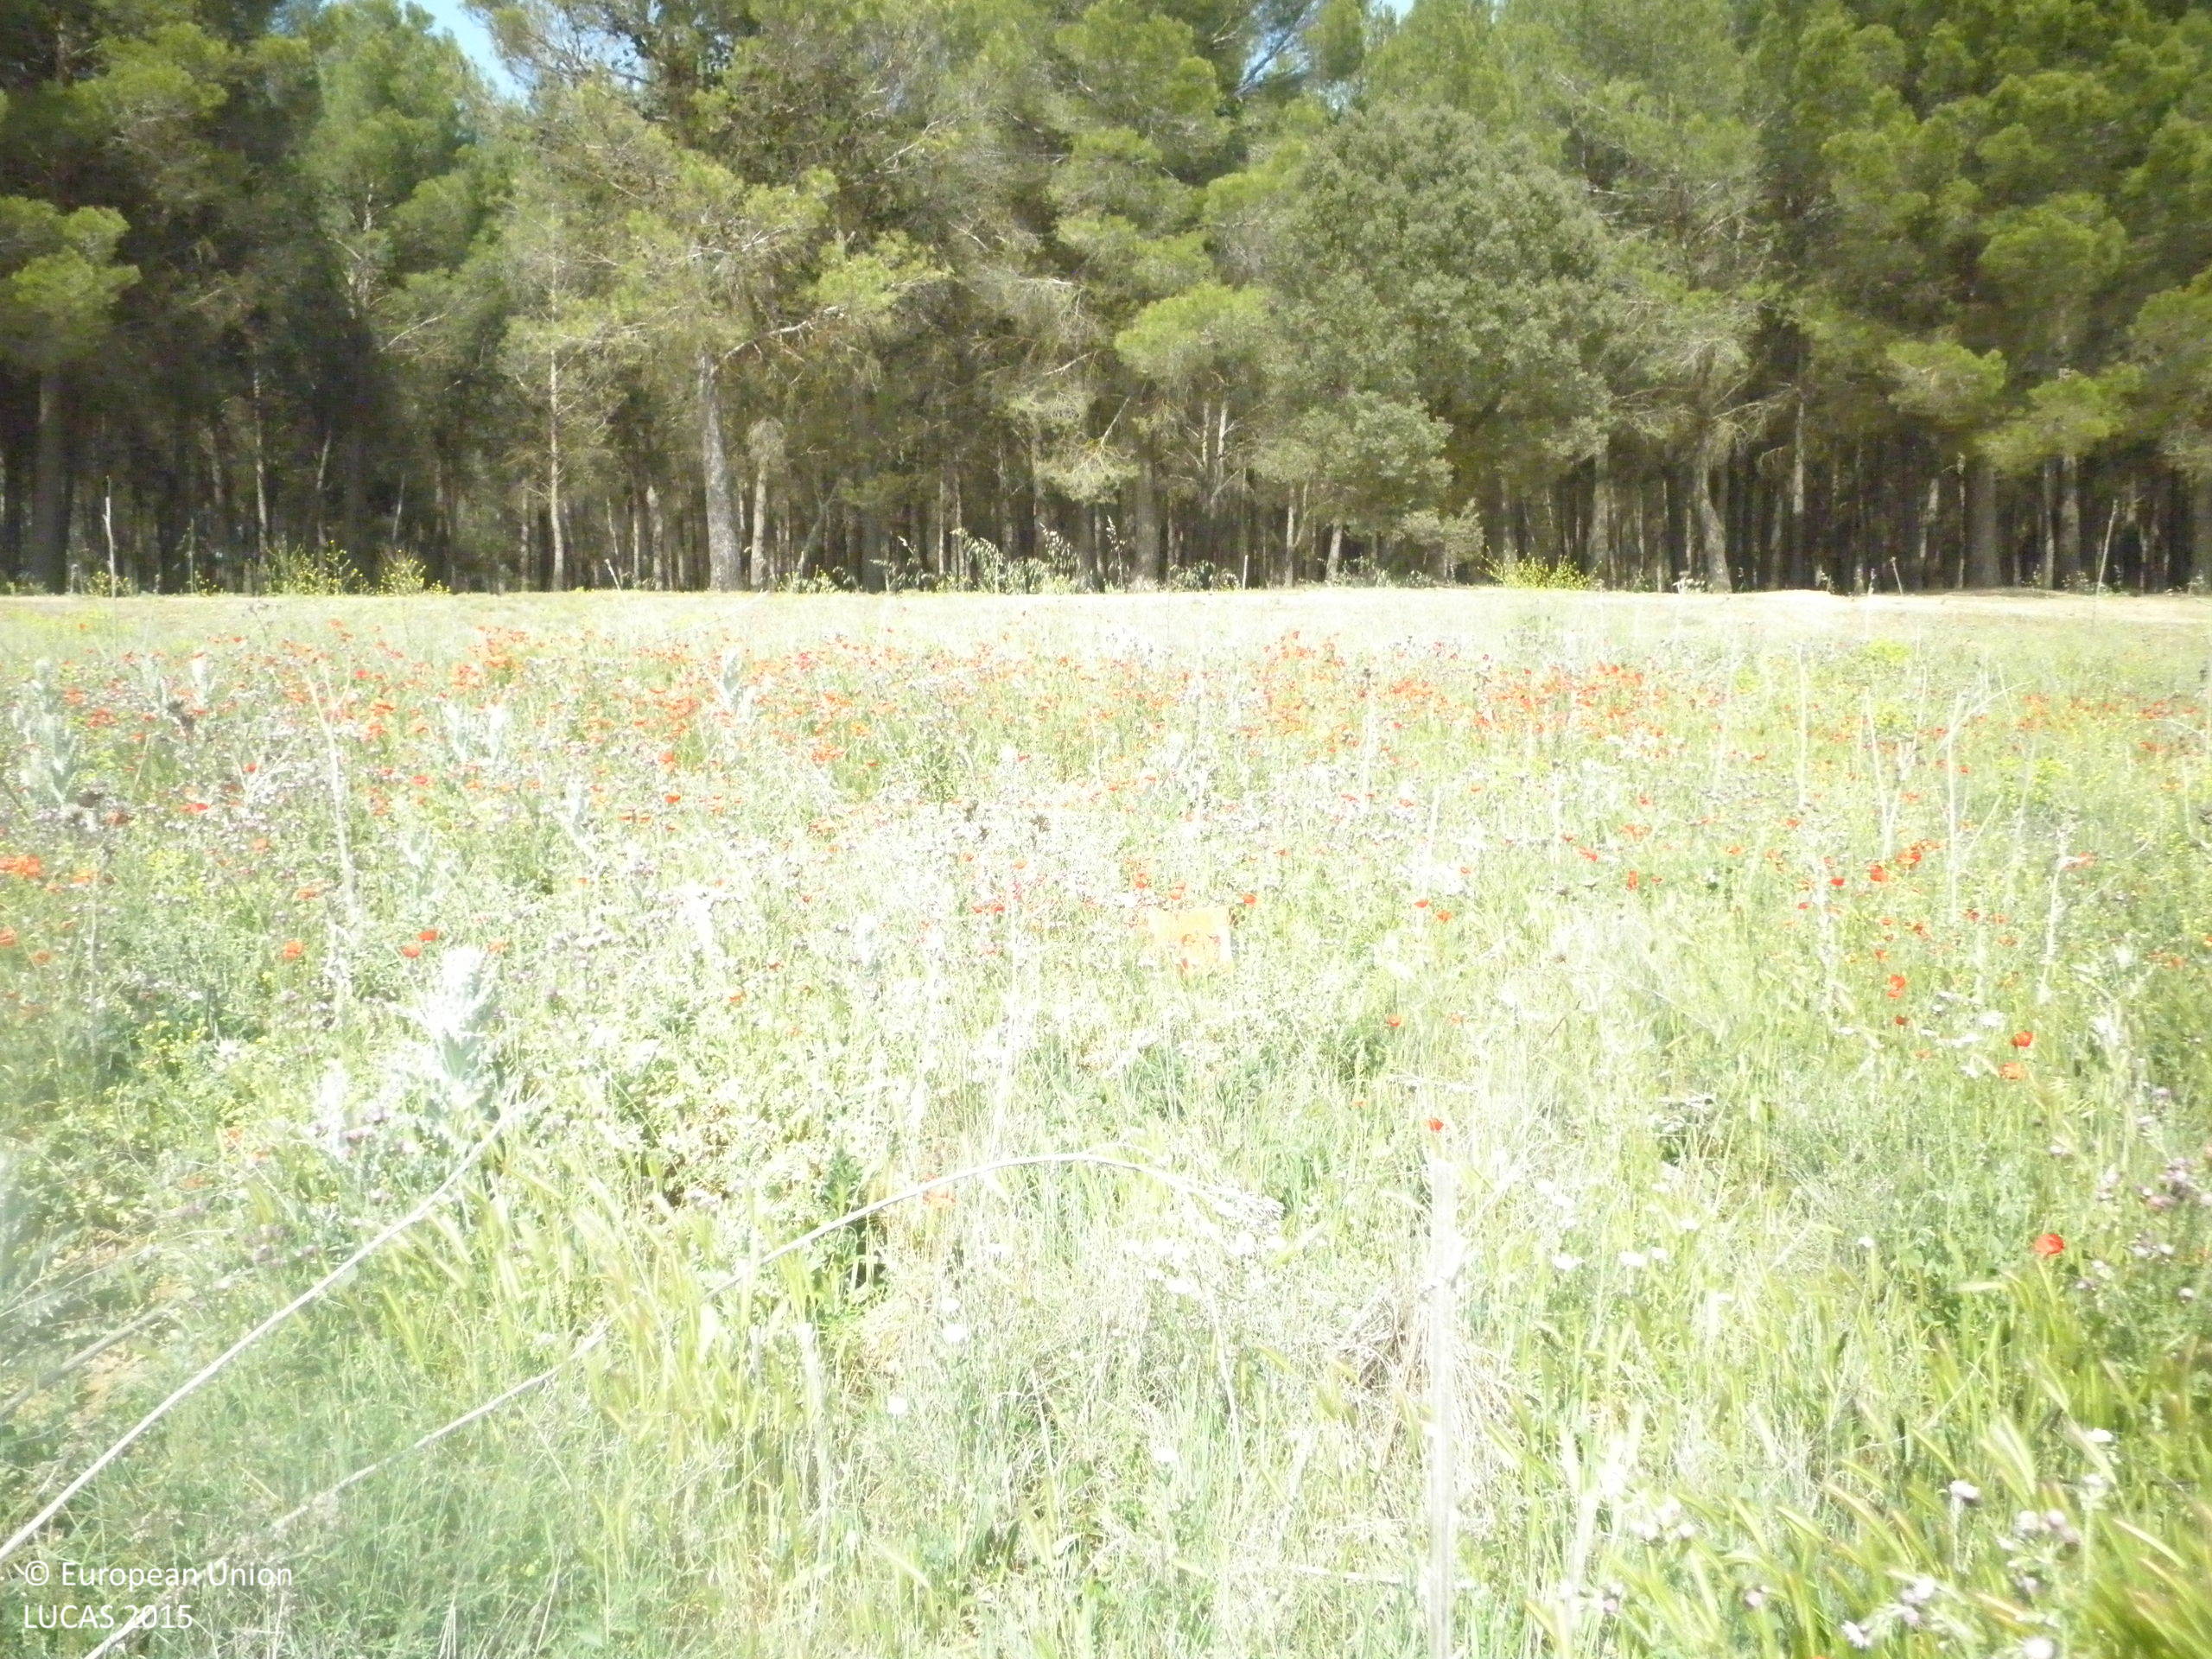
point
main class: Grassland
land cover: Grassland without tree/shrub cover
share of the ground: > 75 %
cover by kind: herbaceous plants 90 %, consolidated bare surface 10 %
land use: Abandoned areas
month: May
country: ES
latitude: 39.5346
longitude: -2.8020
